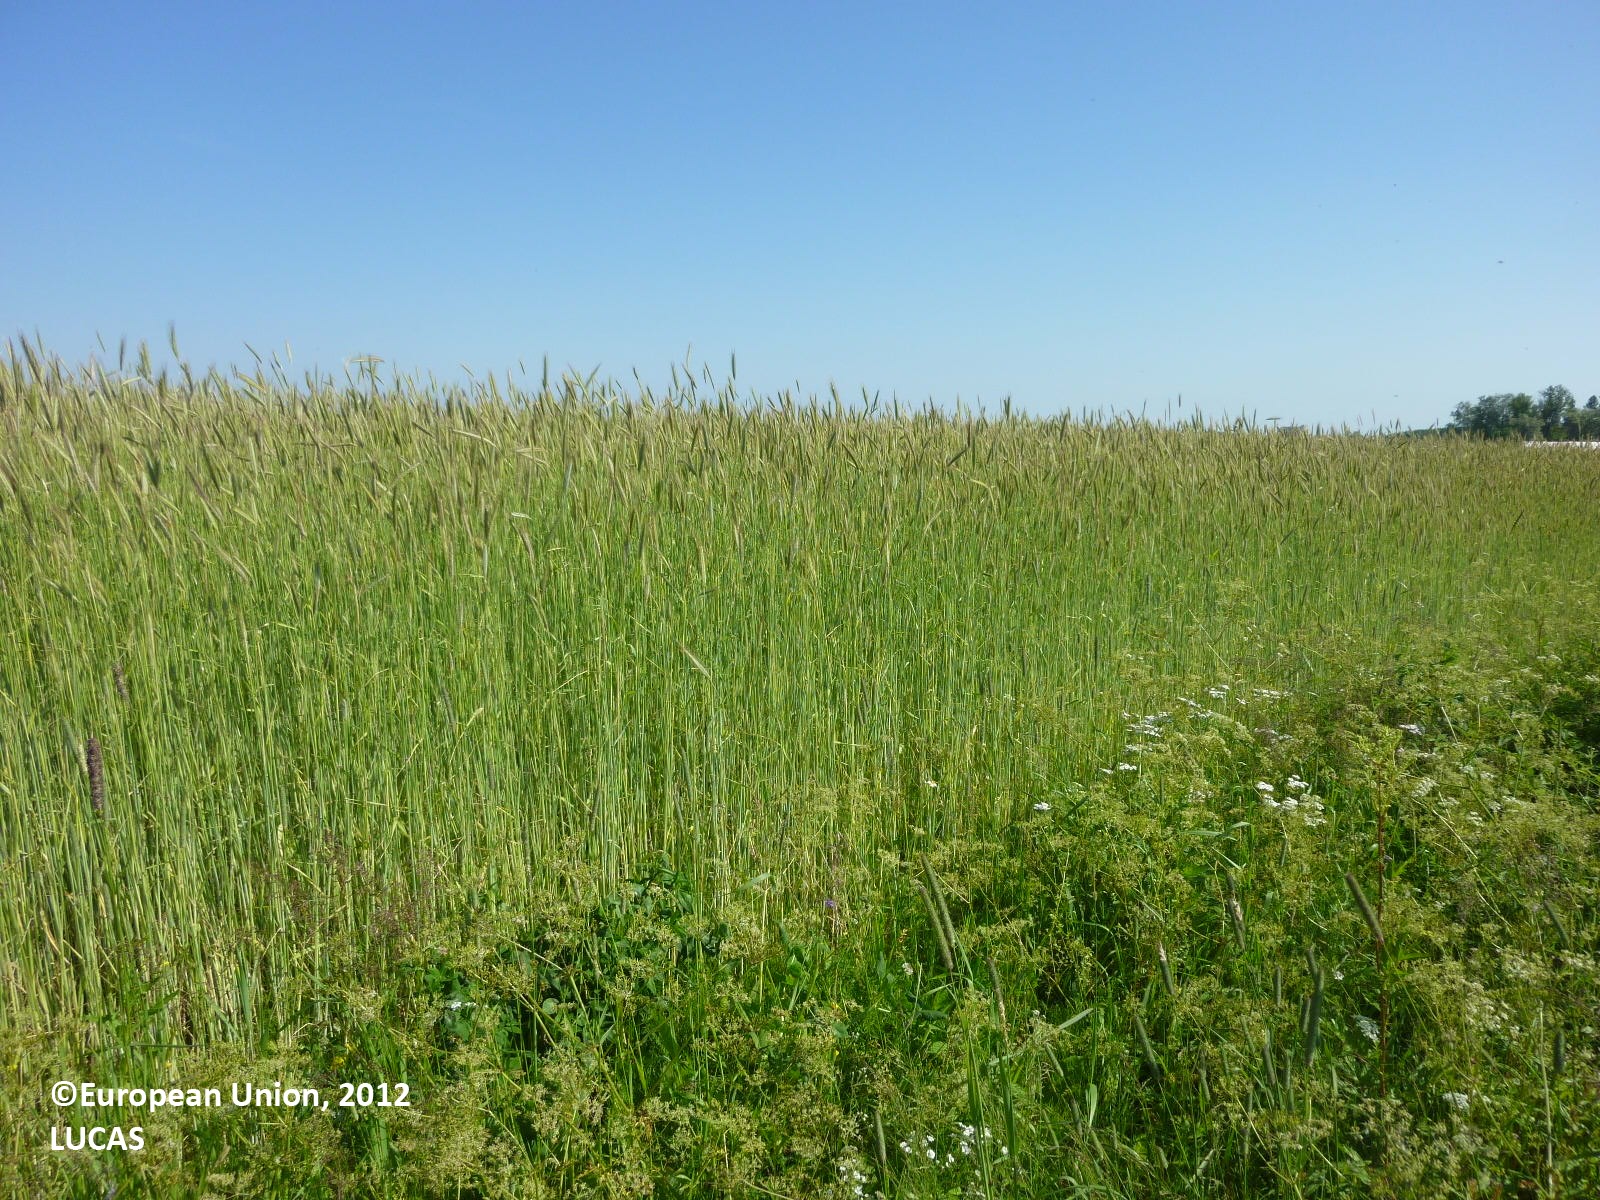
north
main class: Cropland
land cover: Rye
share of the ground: > 75 %
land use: Agriculture (excluding fallow land and kitchen gardens)
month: July
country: FI
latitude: 61.2400
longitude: 22.3790
